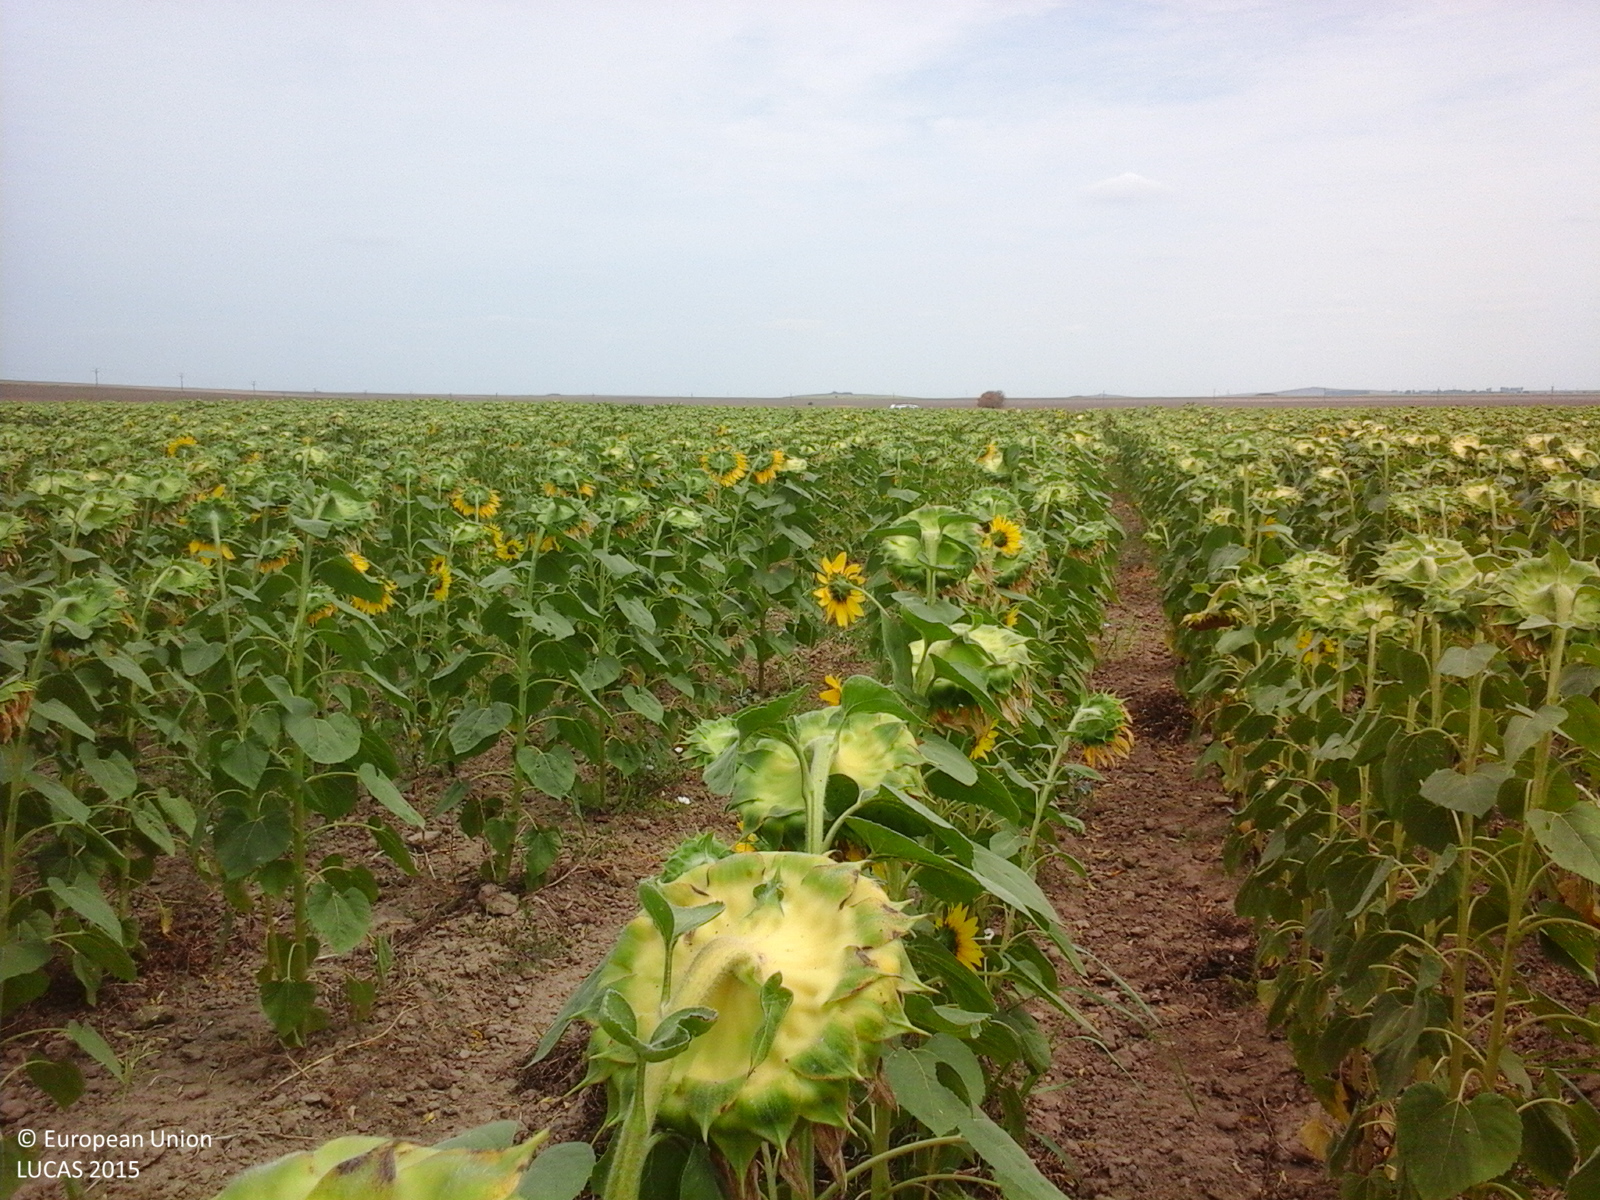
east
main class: Cropland
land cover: Sunflower
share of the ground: > 75 %
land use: Agriculture (excluding fallow land and kitchen gardens)
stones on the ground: < 10 %
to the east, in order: Sunflower; Tracks; Other bare soil
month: August
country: RO
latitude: 45.0386
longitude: 29.0764
